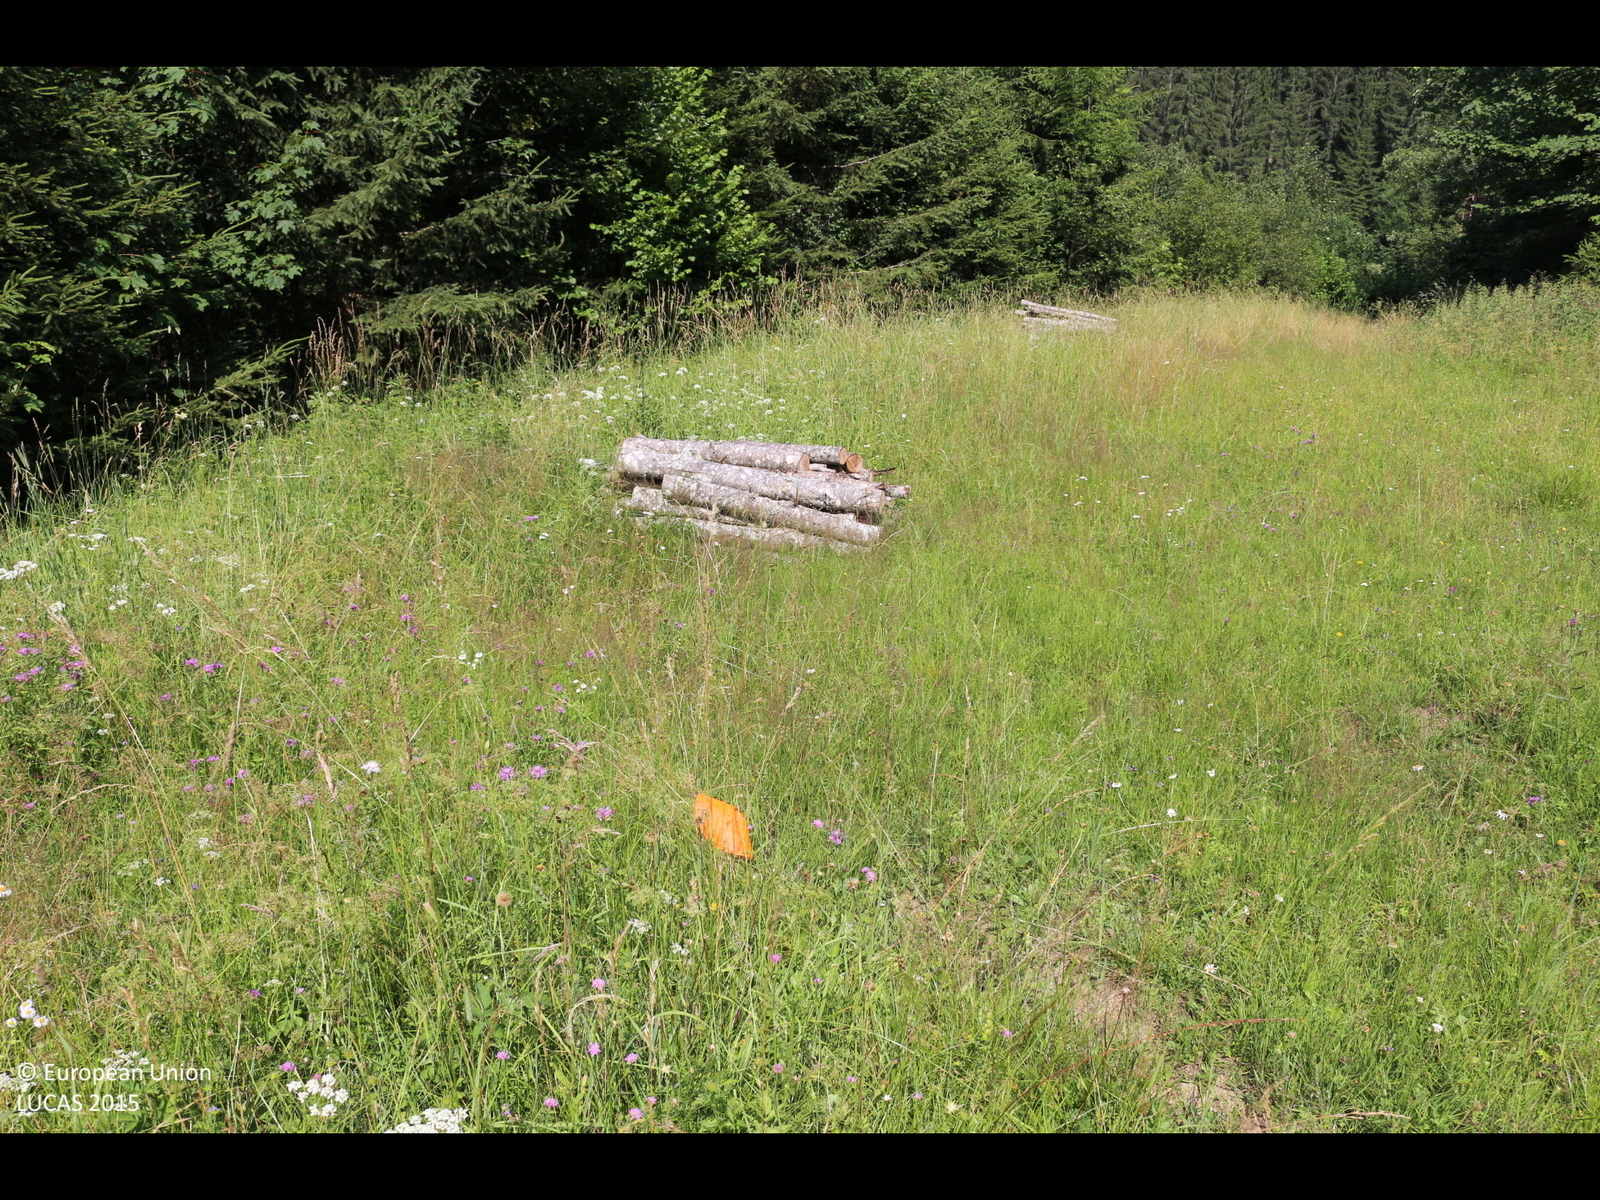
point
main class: Grassland
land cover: Grassland without tree/shrub cover
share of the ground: > 75 %
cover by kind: herbaceous plants 100 %
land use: Agriculture (excluding fallow land and kitchen gardens)
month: July
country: AT
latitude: 46.7777
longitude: 14.0969
